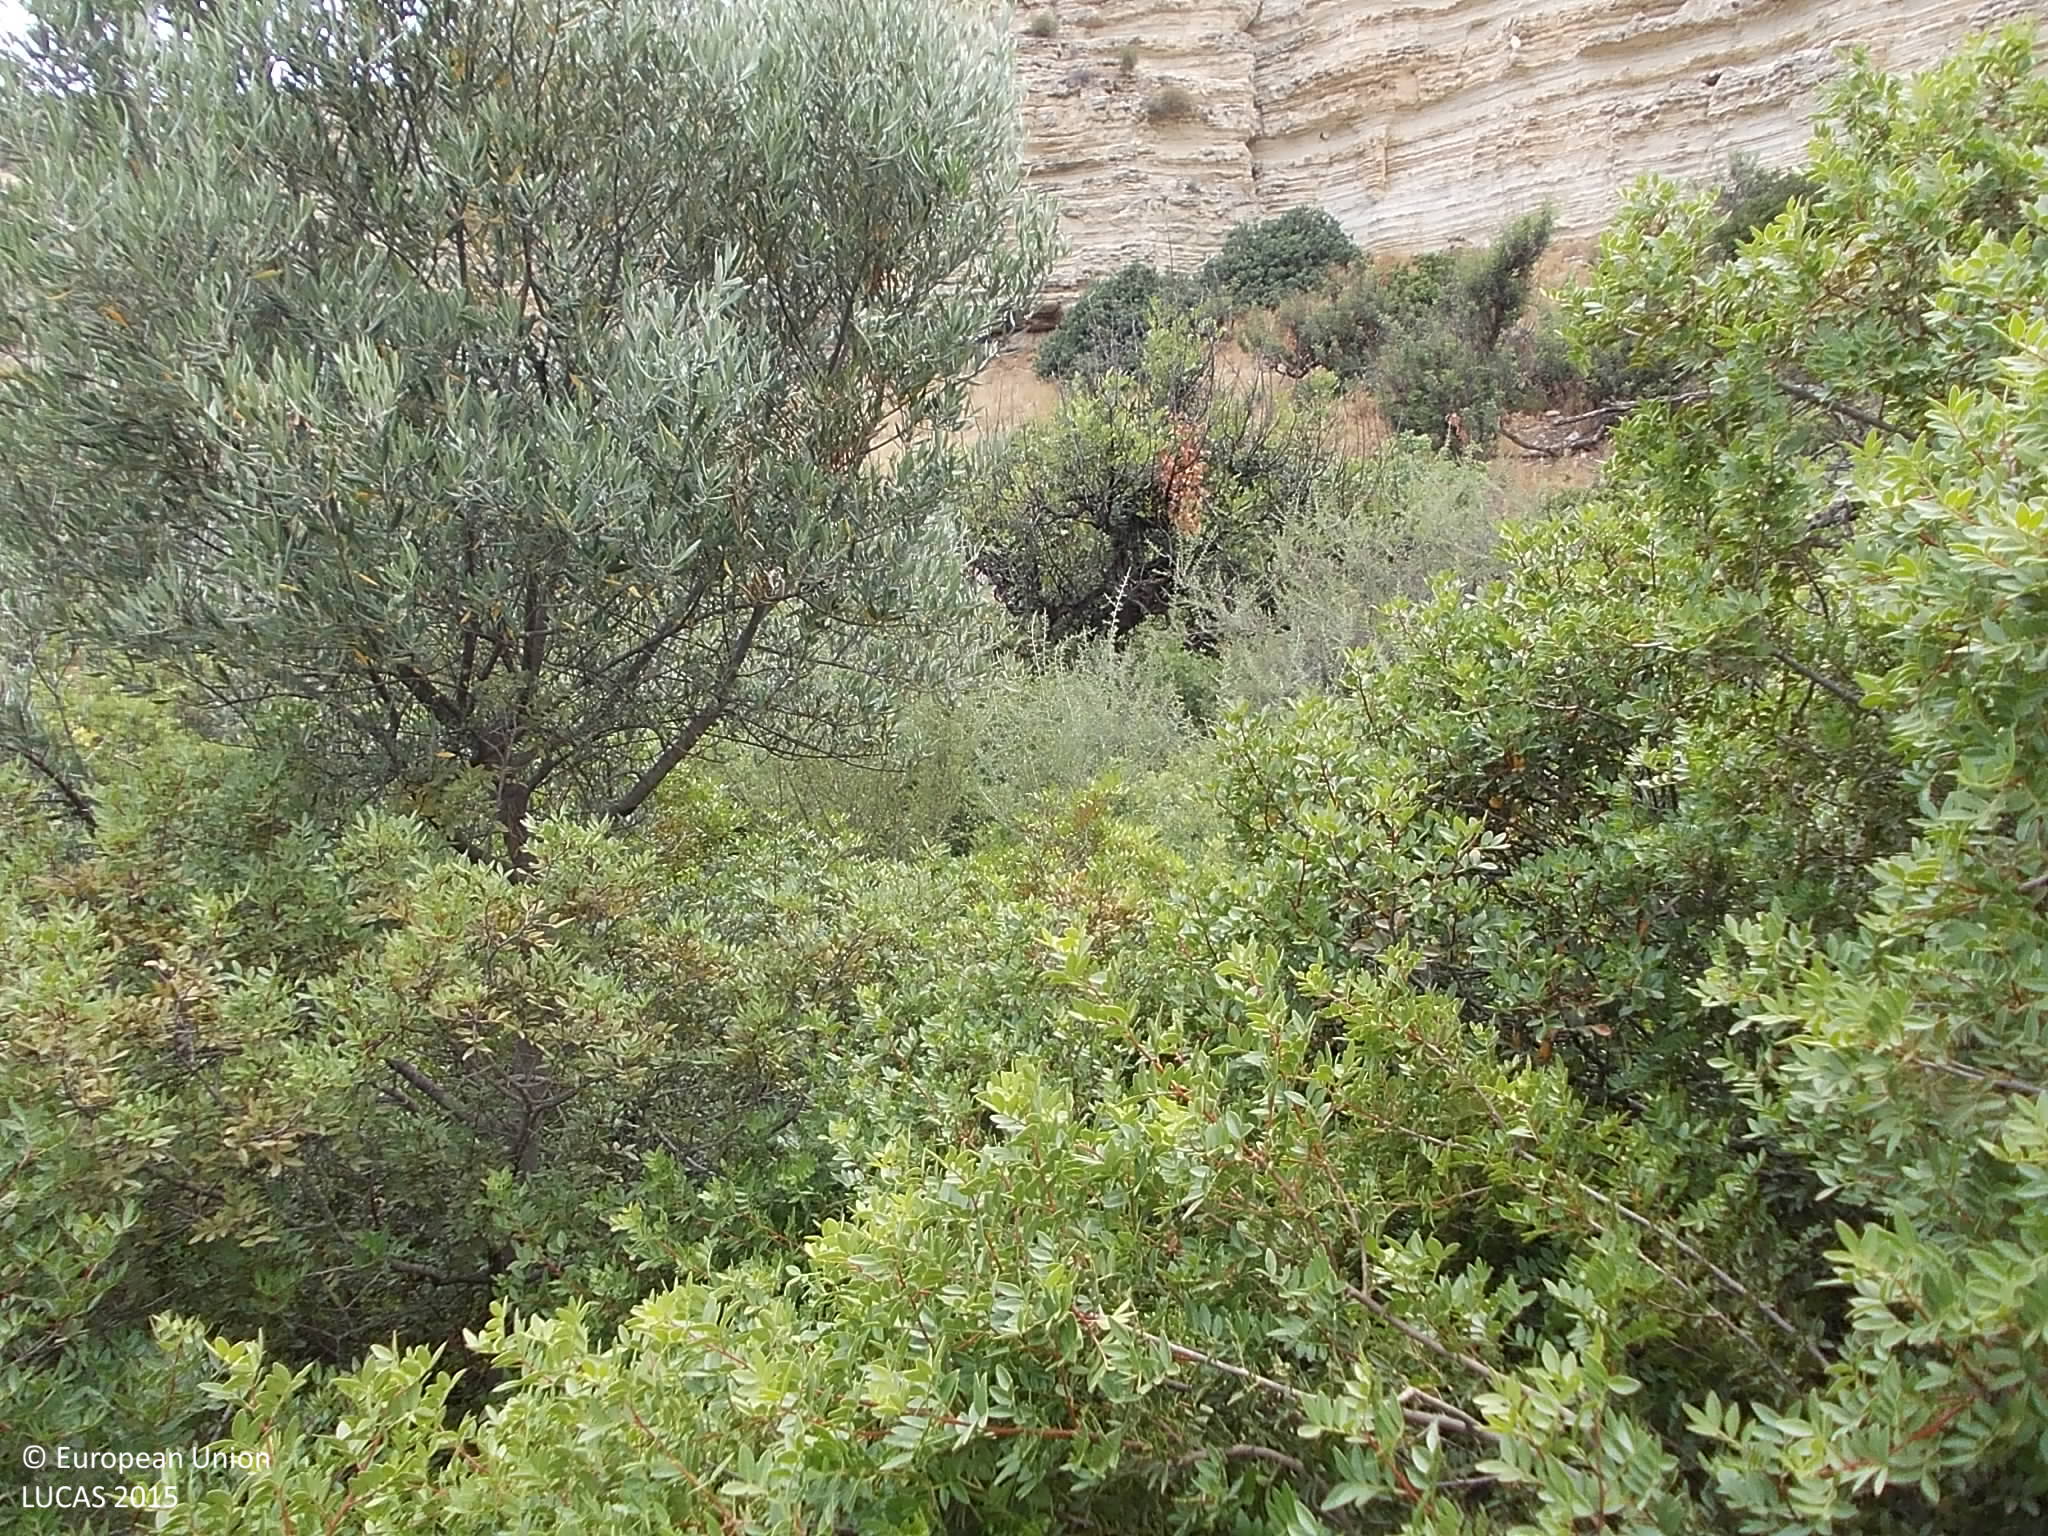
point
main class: Shrubland
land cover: Shrubland with sparse tree cover
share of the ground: > 75 %
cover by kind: shrubs 95 %, broadleaved forest trees 5 %
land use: Semi-natural and natural areas not in use
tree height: < 5 m
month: May
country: CY
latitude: 34.7158
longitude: 32.7917
